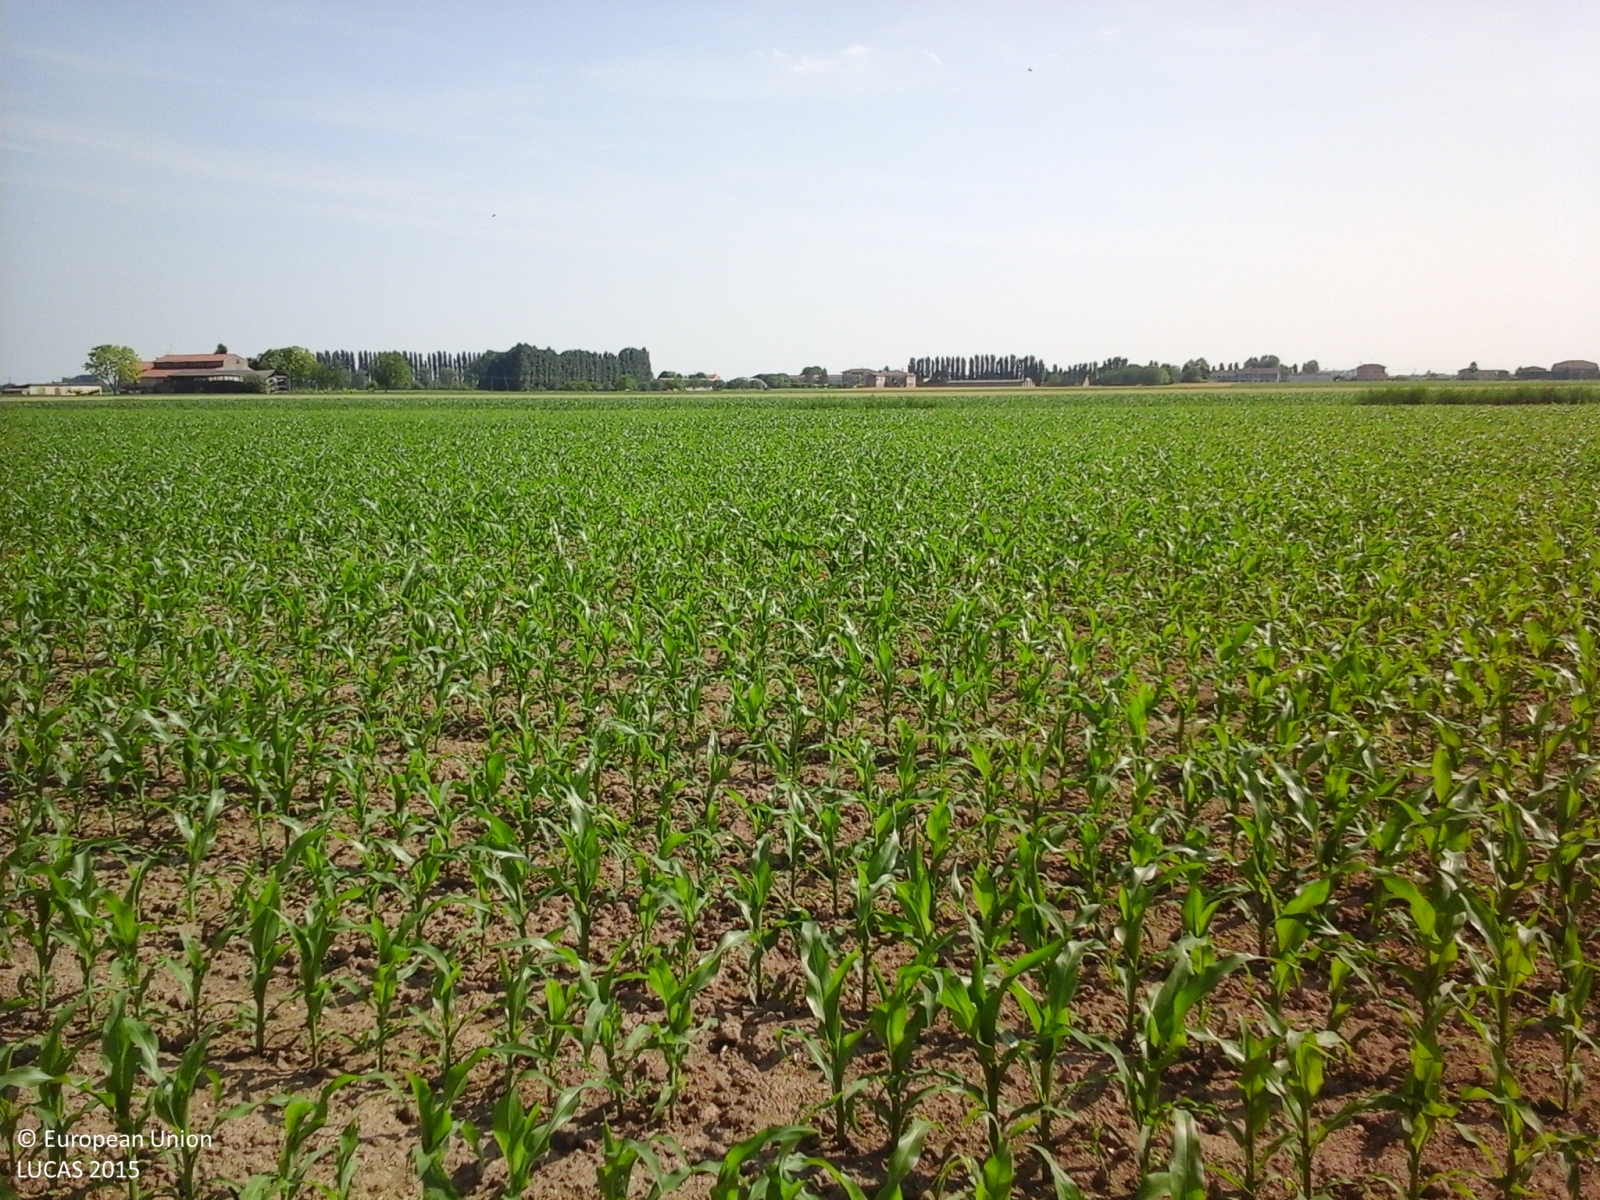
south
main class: Cropland
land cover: Maize
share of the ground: 25 - 50 %
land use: Agriculture (excluding fallow land and kitchen gardens)
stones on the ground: < 10 %
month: May
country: IT
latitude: 45.2119
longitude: 10.9278
